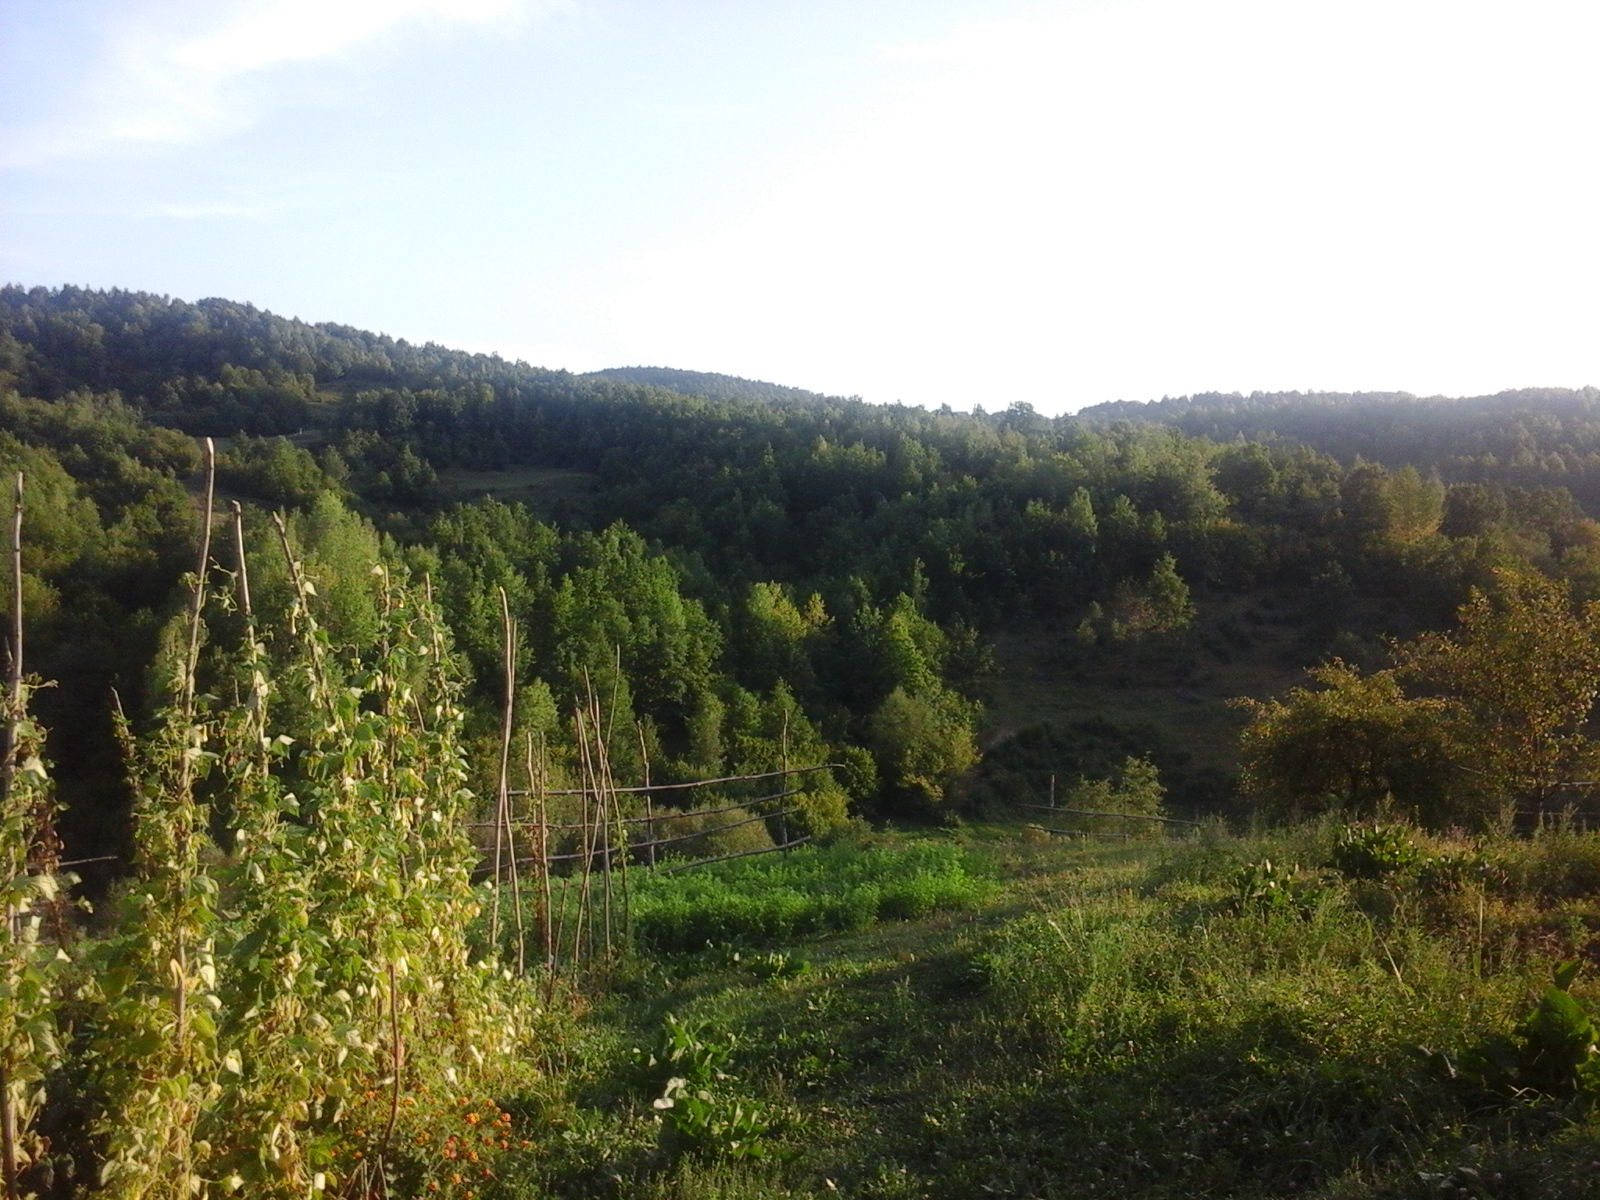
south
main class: Grassland
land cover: Spontaneously vegetated surfaces
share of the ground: > 75 %
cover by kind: herbaceous plants 100 %
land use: Agriculture (excluding fallow land and kitchen gardens)
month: September
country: RO
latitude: 47.7248
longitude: 24.1530
